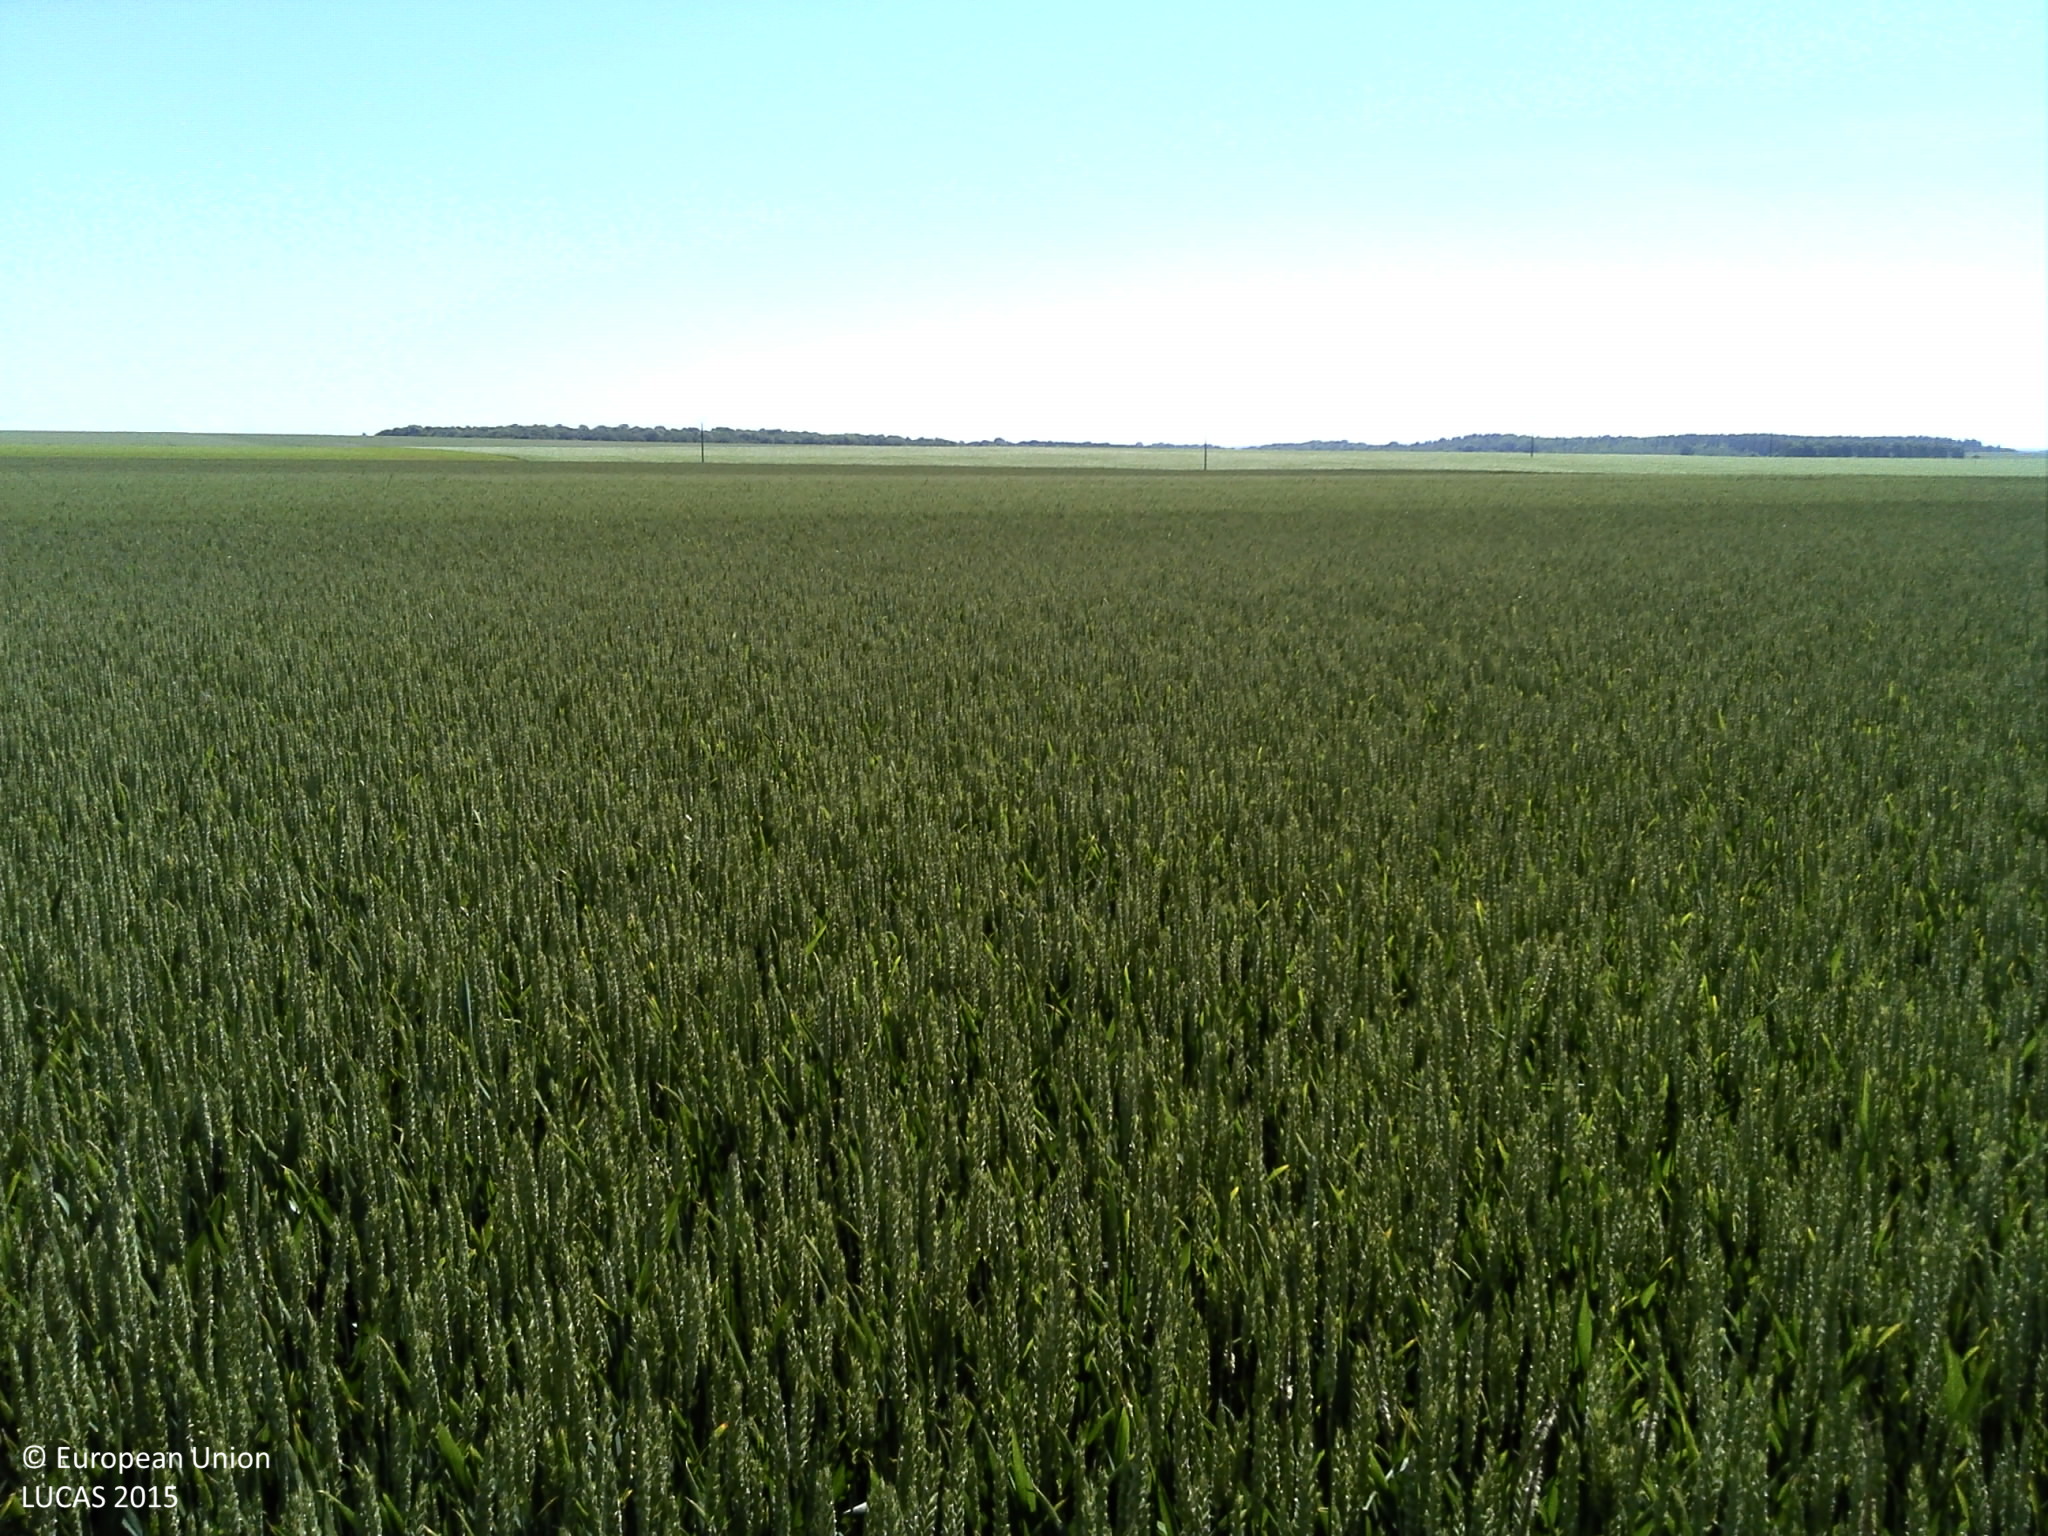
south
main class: Cropland
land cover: Rape and turnip rape
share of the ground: > 75 %
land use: Agriculture (excluding fallow land and kitchen gardens)
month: June
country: FR
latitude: 49.1610
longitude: 6.0364
